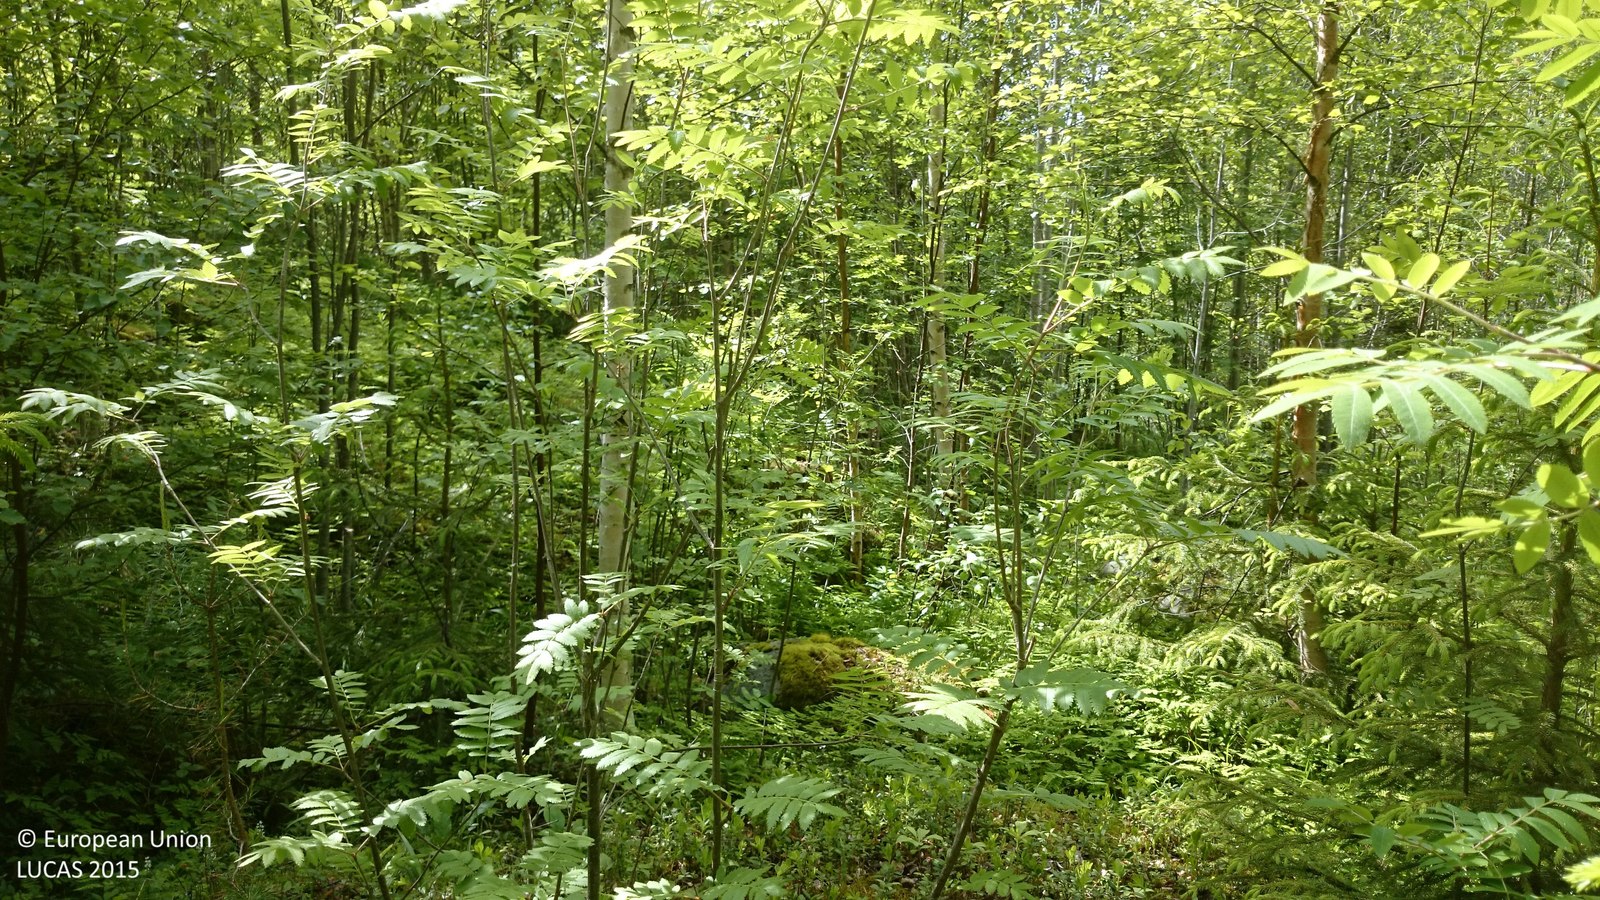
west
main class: Woodland
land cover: Other mixed woodland
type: boreal forest
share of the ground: 50 - 75 %
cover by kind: broadleaved forest trees 35 %, coniferous forest trees 30 %, herbaceous plants 20 %, lichens and mosses 15 %
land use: Forestry
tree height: > 5 m
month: June
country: SE
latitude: 62.0813
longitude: 16.7396
